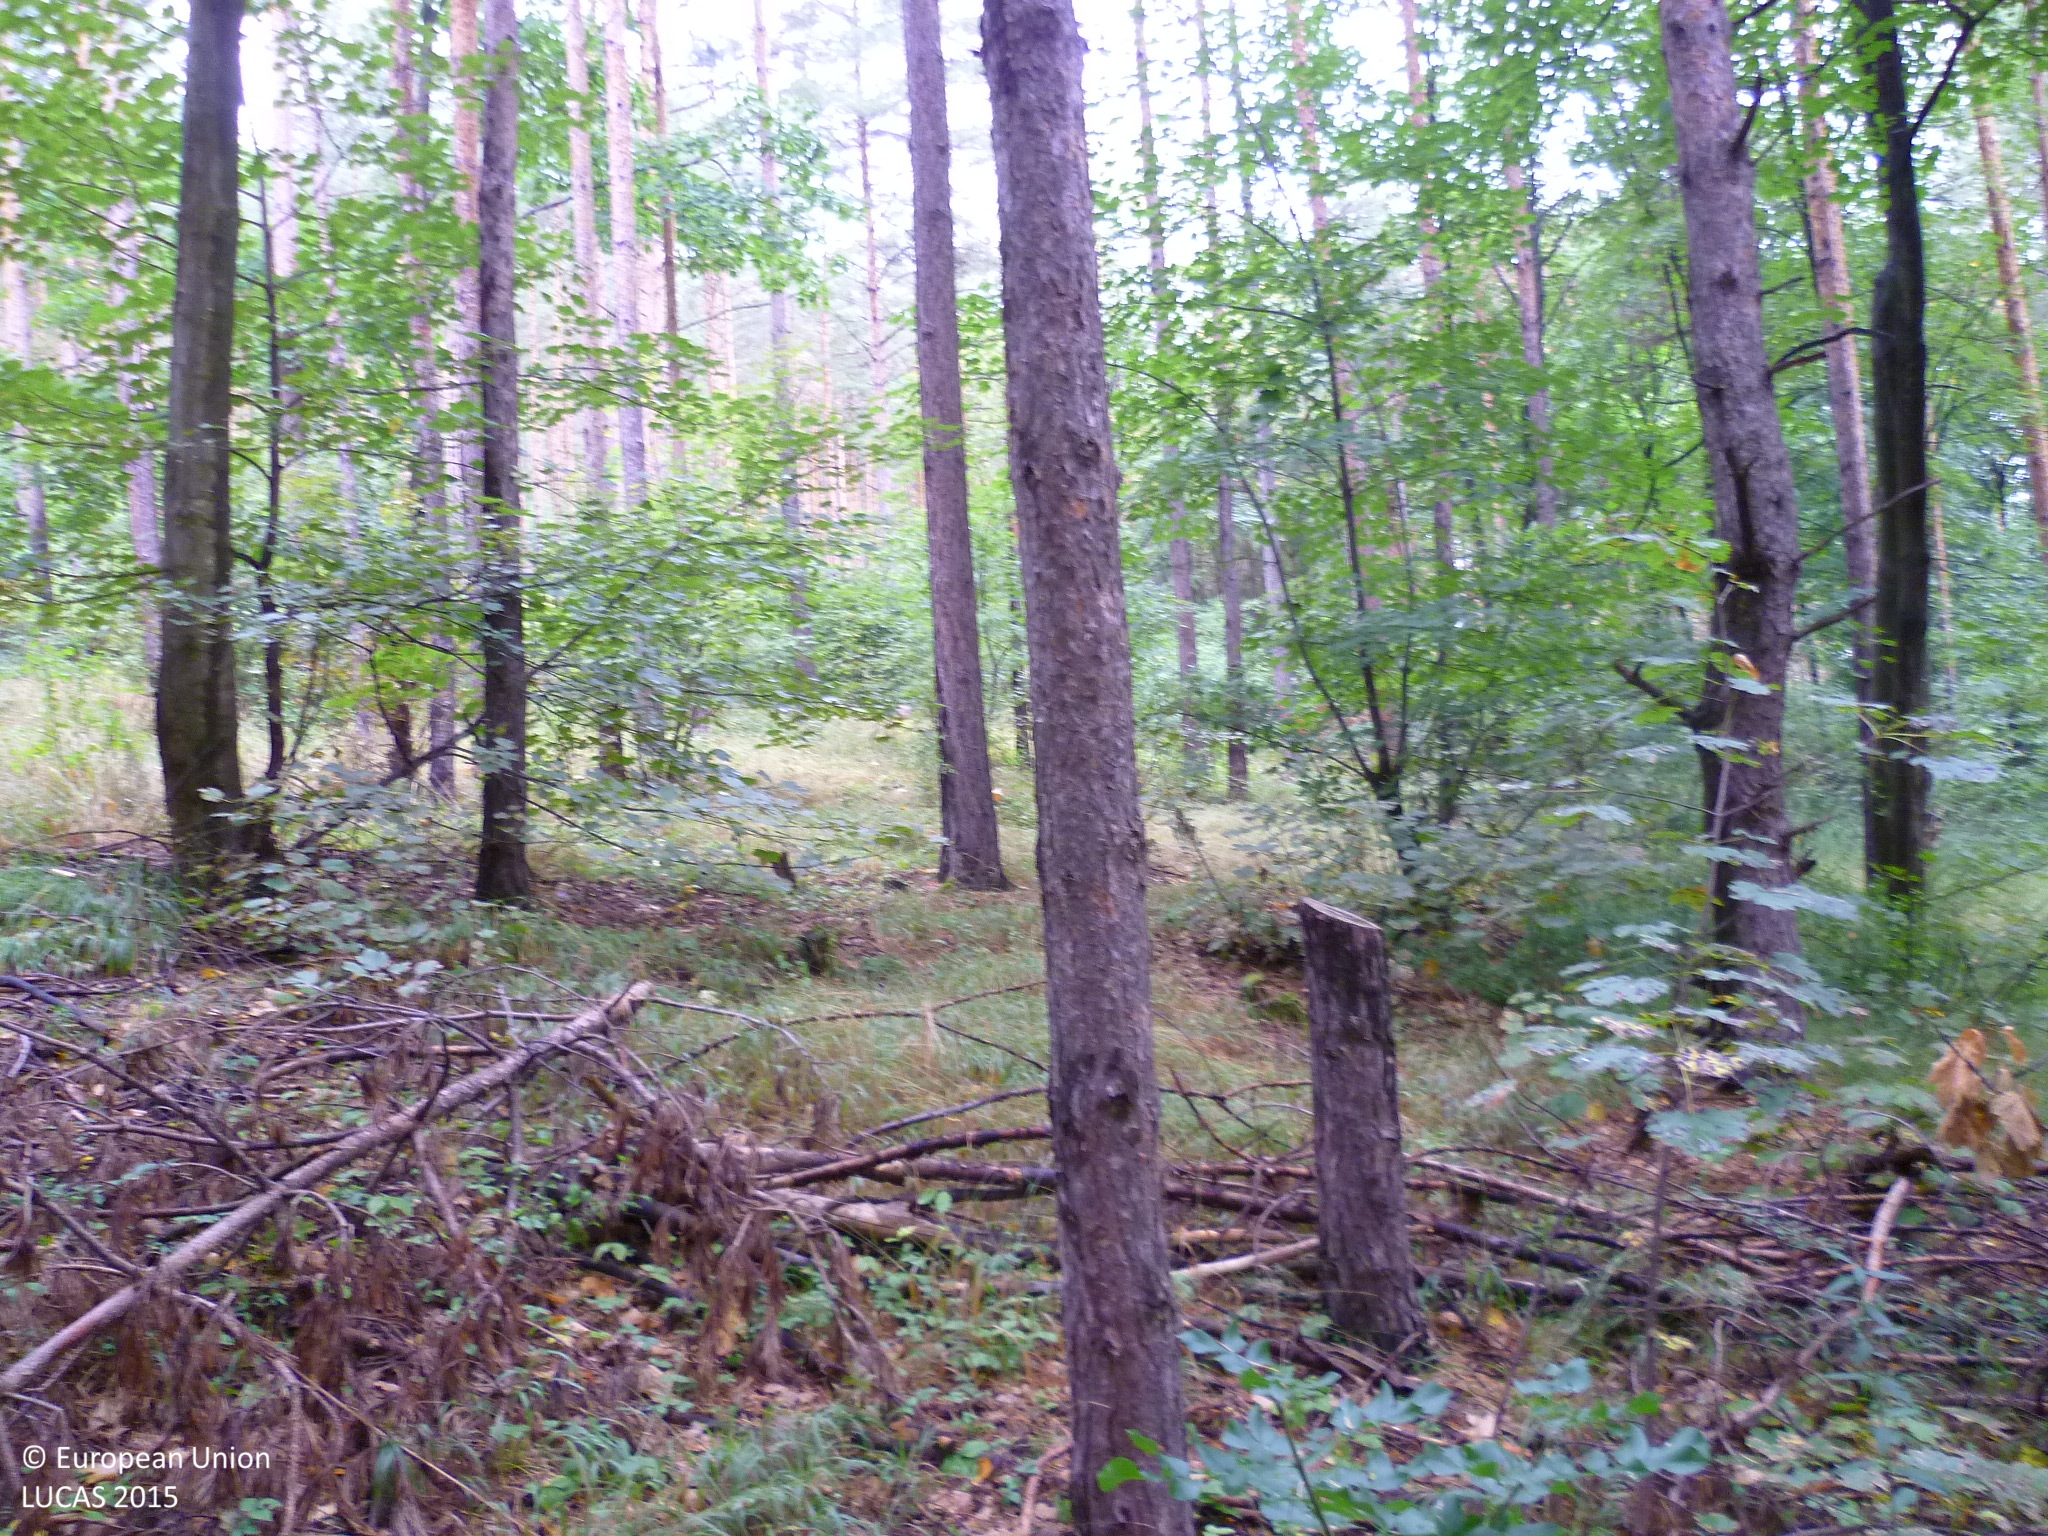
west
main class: Woodland
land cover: Pine dominated mixed woodland
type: alpine coniferous forest
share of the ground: 50 - 75 %
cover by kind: coniferous forest trees 50 %, broadleaved forest trees 30 %, unconsolidated bare surface 10 %, shrubs 5 %, herbaceous plants 5 %
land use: Forestry
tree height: > 5 m
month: September
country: BG
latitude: 42.7573
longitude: 22.8953
